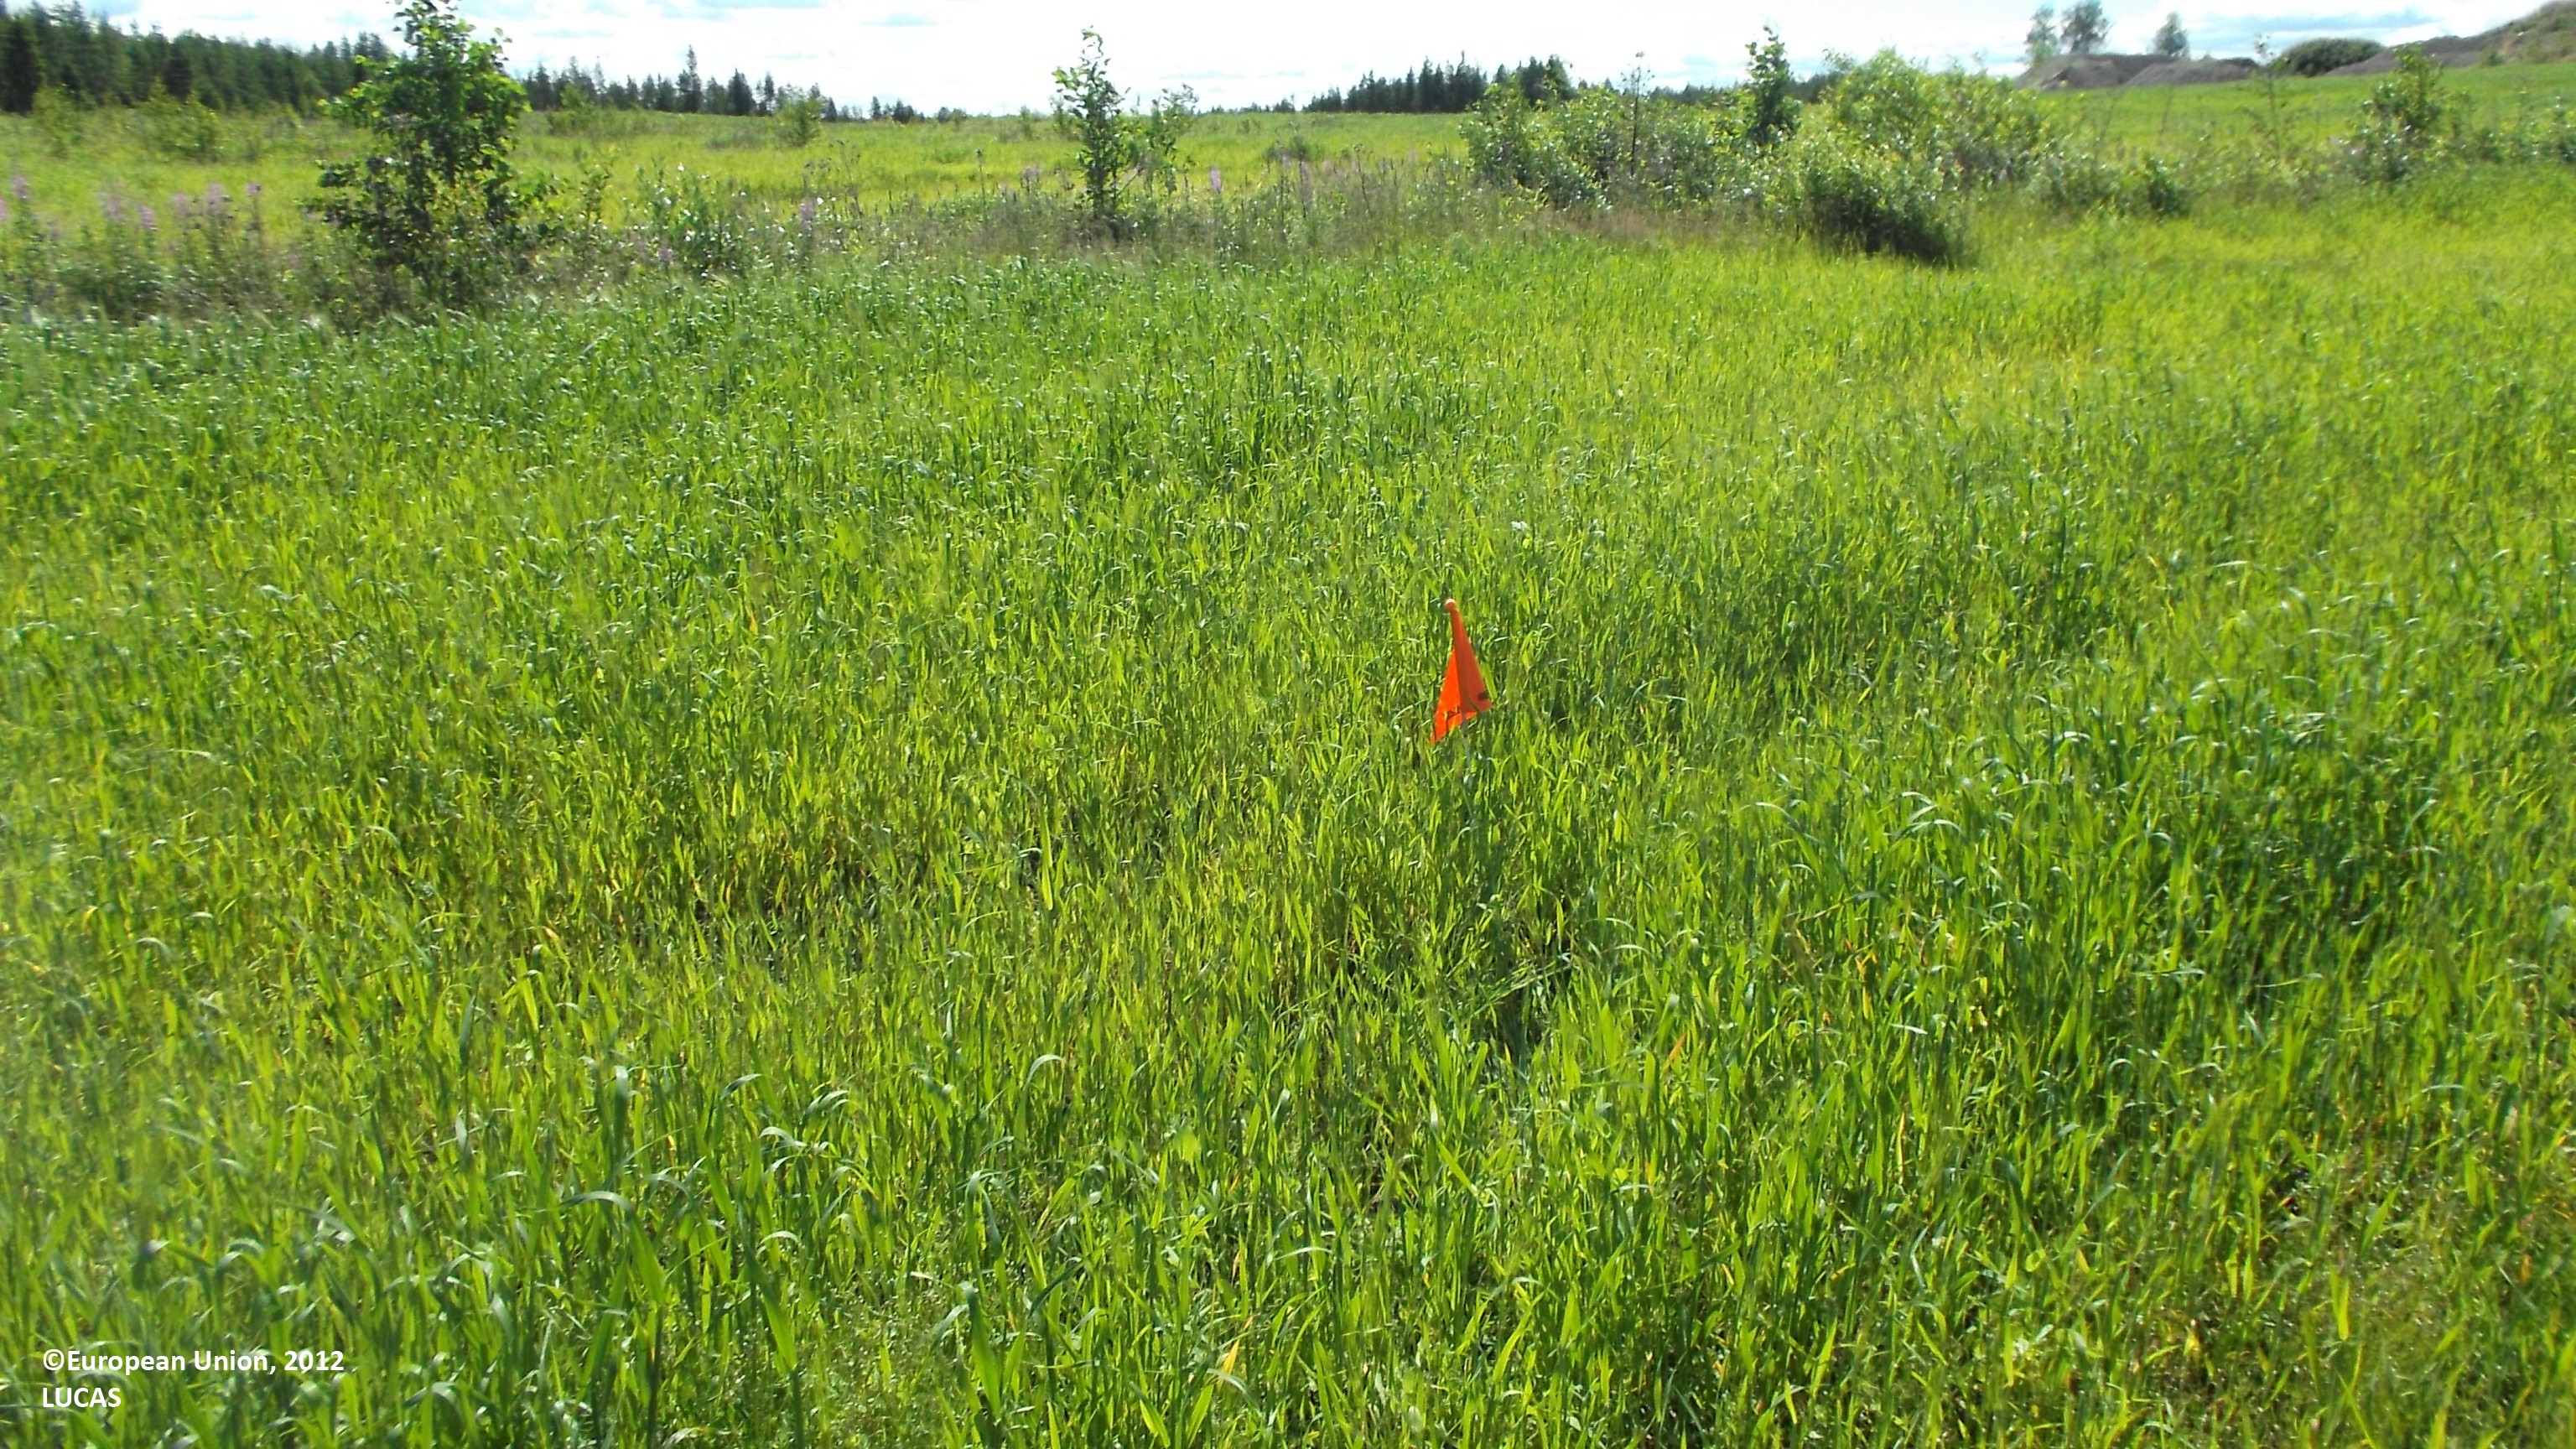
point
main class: Grassland
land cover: Grassland without tree/shrub cover
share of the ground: 25 - 50 %
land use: Fallow land
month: July
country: FI
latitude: 63.3259
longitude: 23.8667
